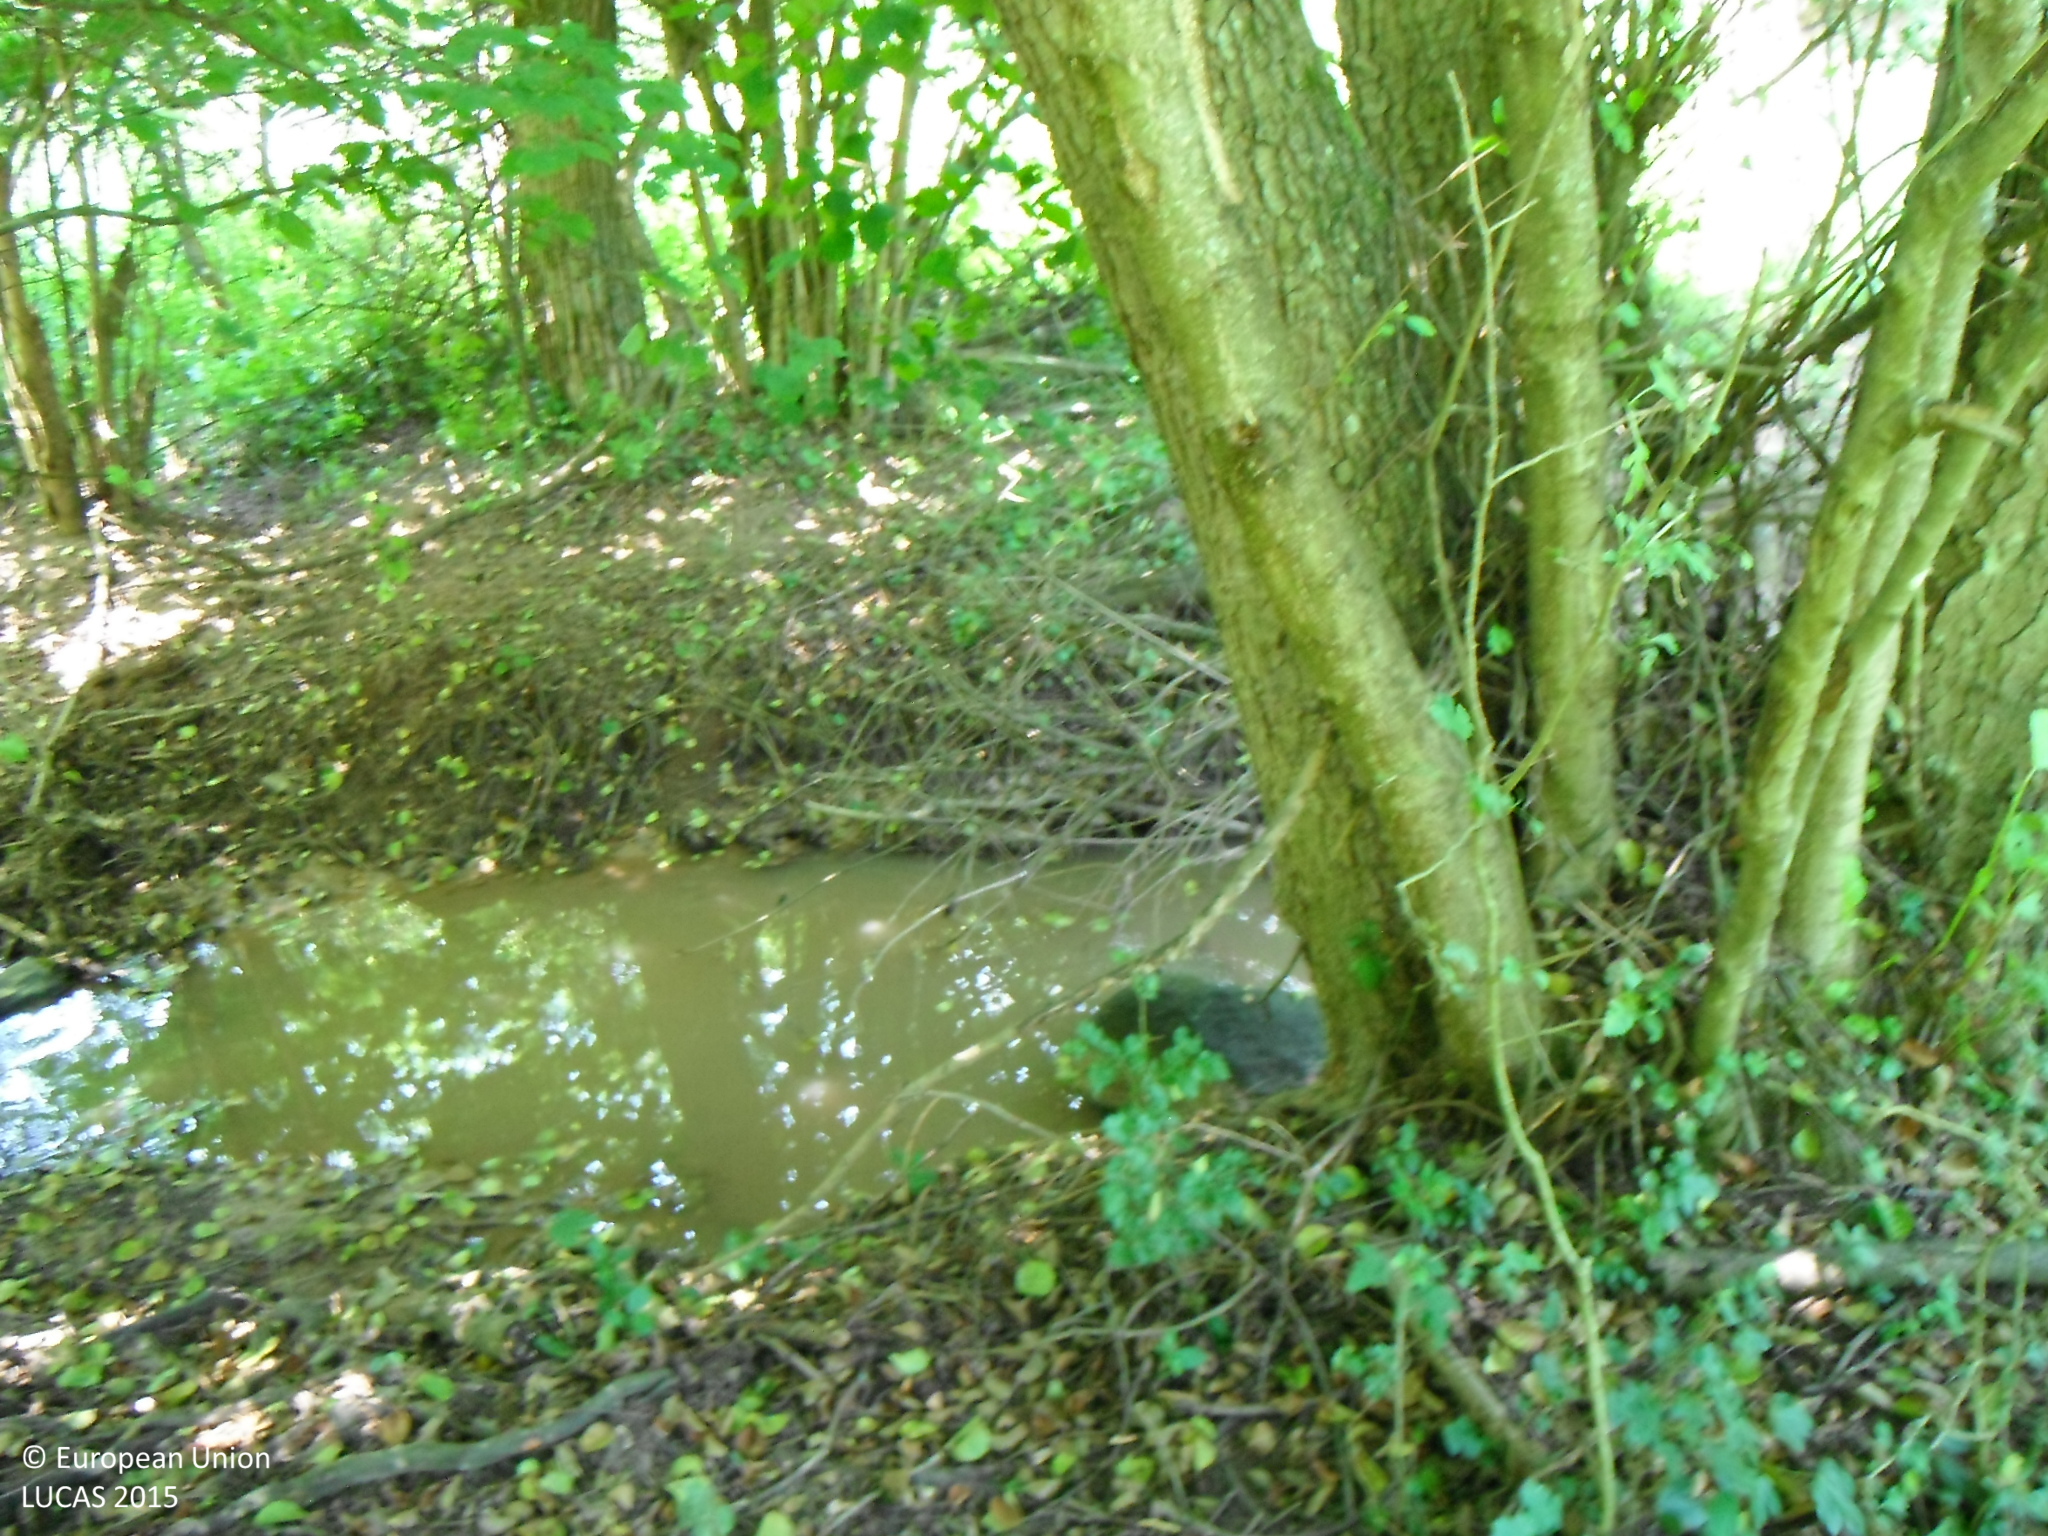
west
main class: Woodland
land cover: Broadleaved woodland
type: floodplain forest
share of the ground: > 75 %
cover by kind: broadleaved forest trees 100 %
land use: Forestry
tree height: > 5 m
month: July
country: SK
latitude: 48.2373
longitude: 19.1906
